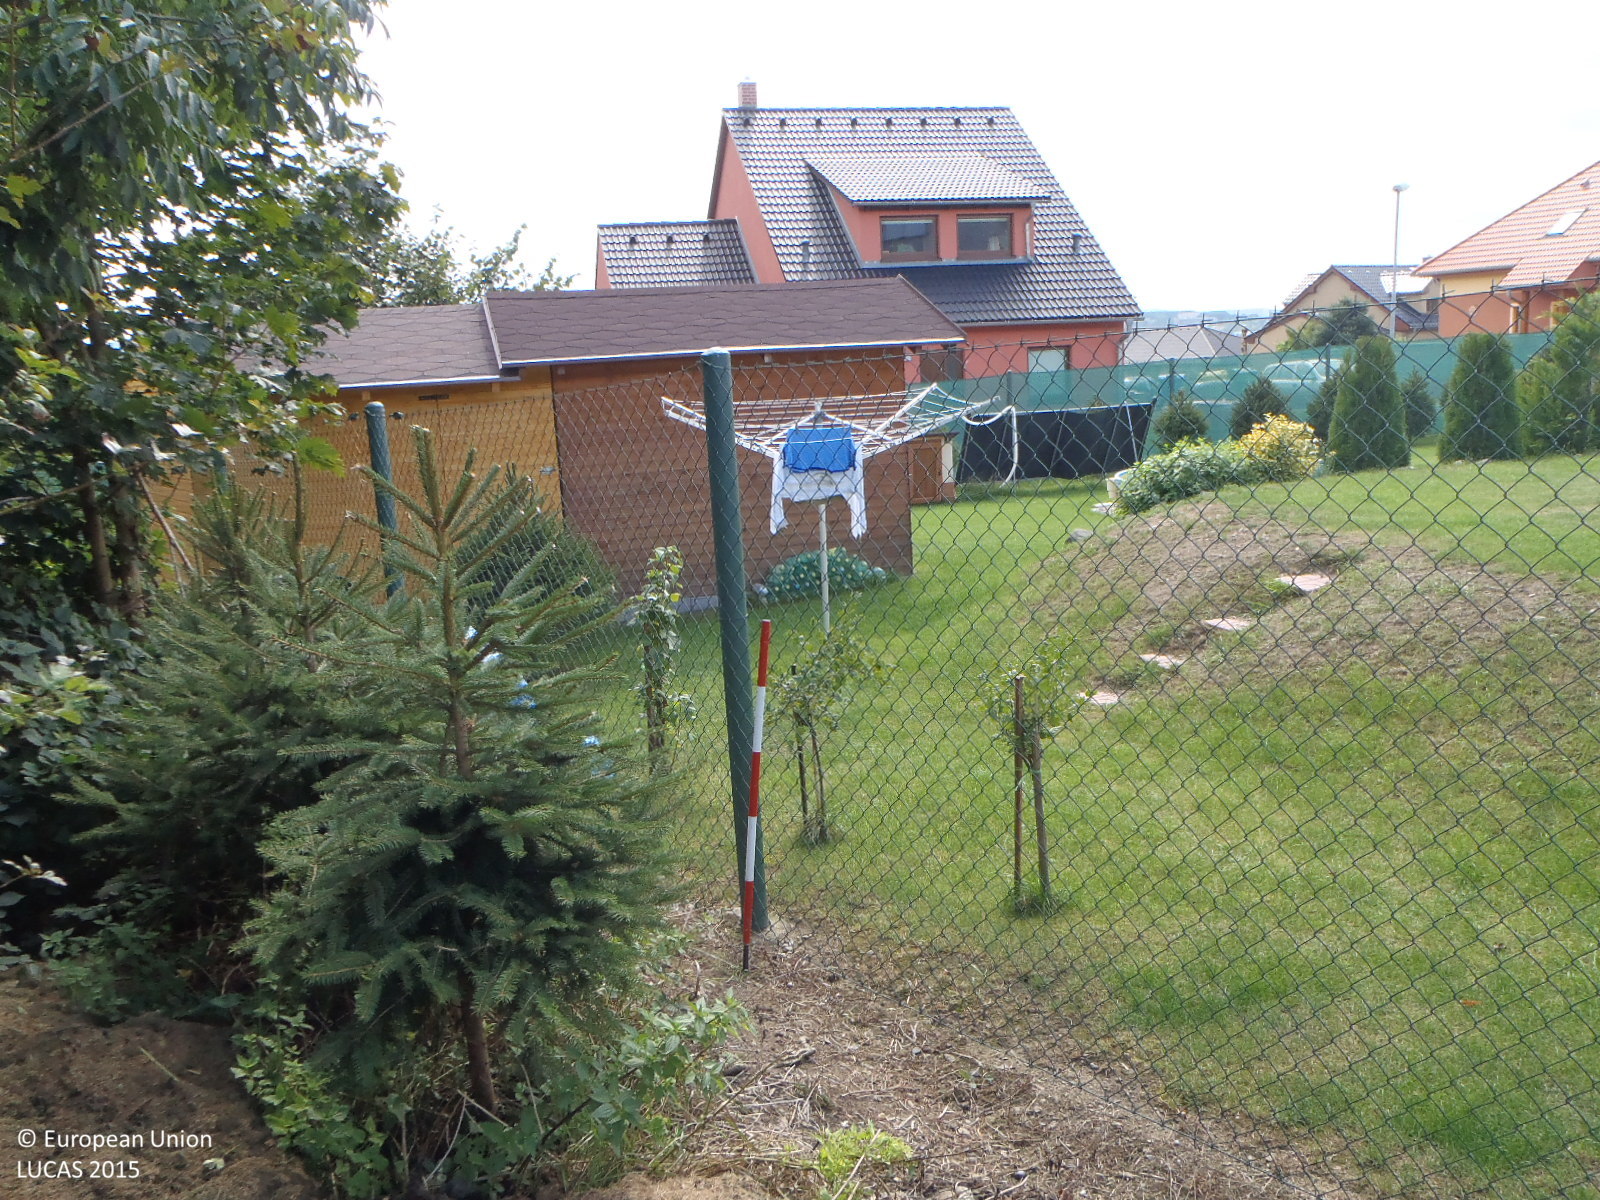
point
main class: Woodland
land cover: Broadleaved woodland
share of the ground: > 75 %
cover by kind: broadleaved forest trees 90 %, shrubs 10 %
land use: Semi-natural and natural areas not in use
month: September
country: CZ
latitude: 50.6769
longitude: 13.8642
